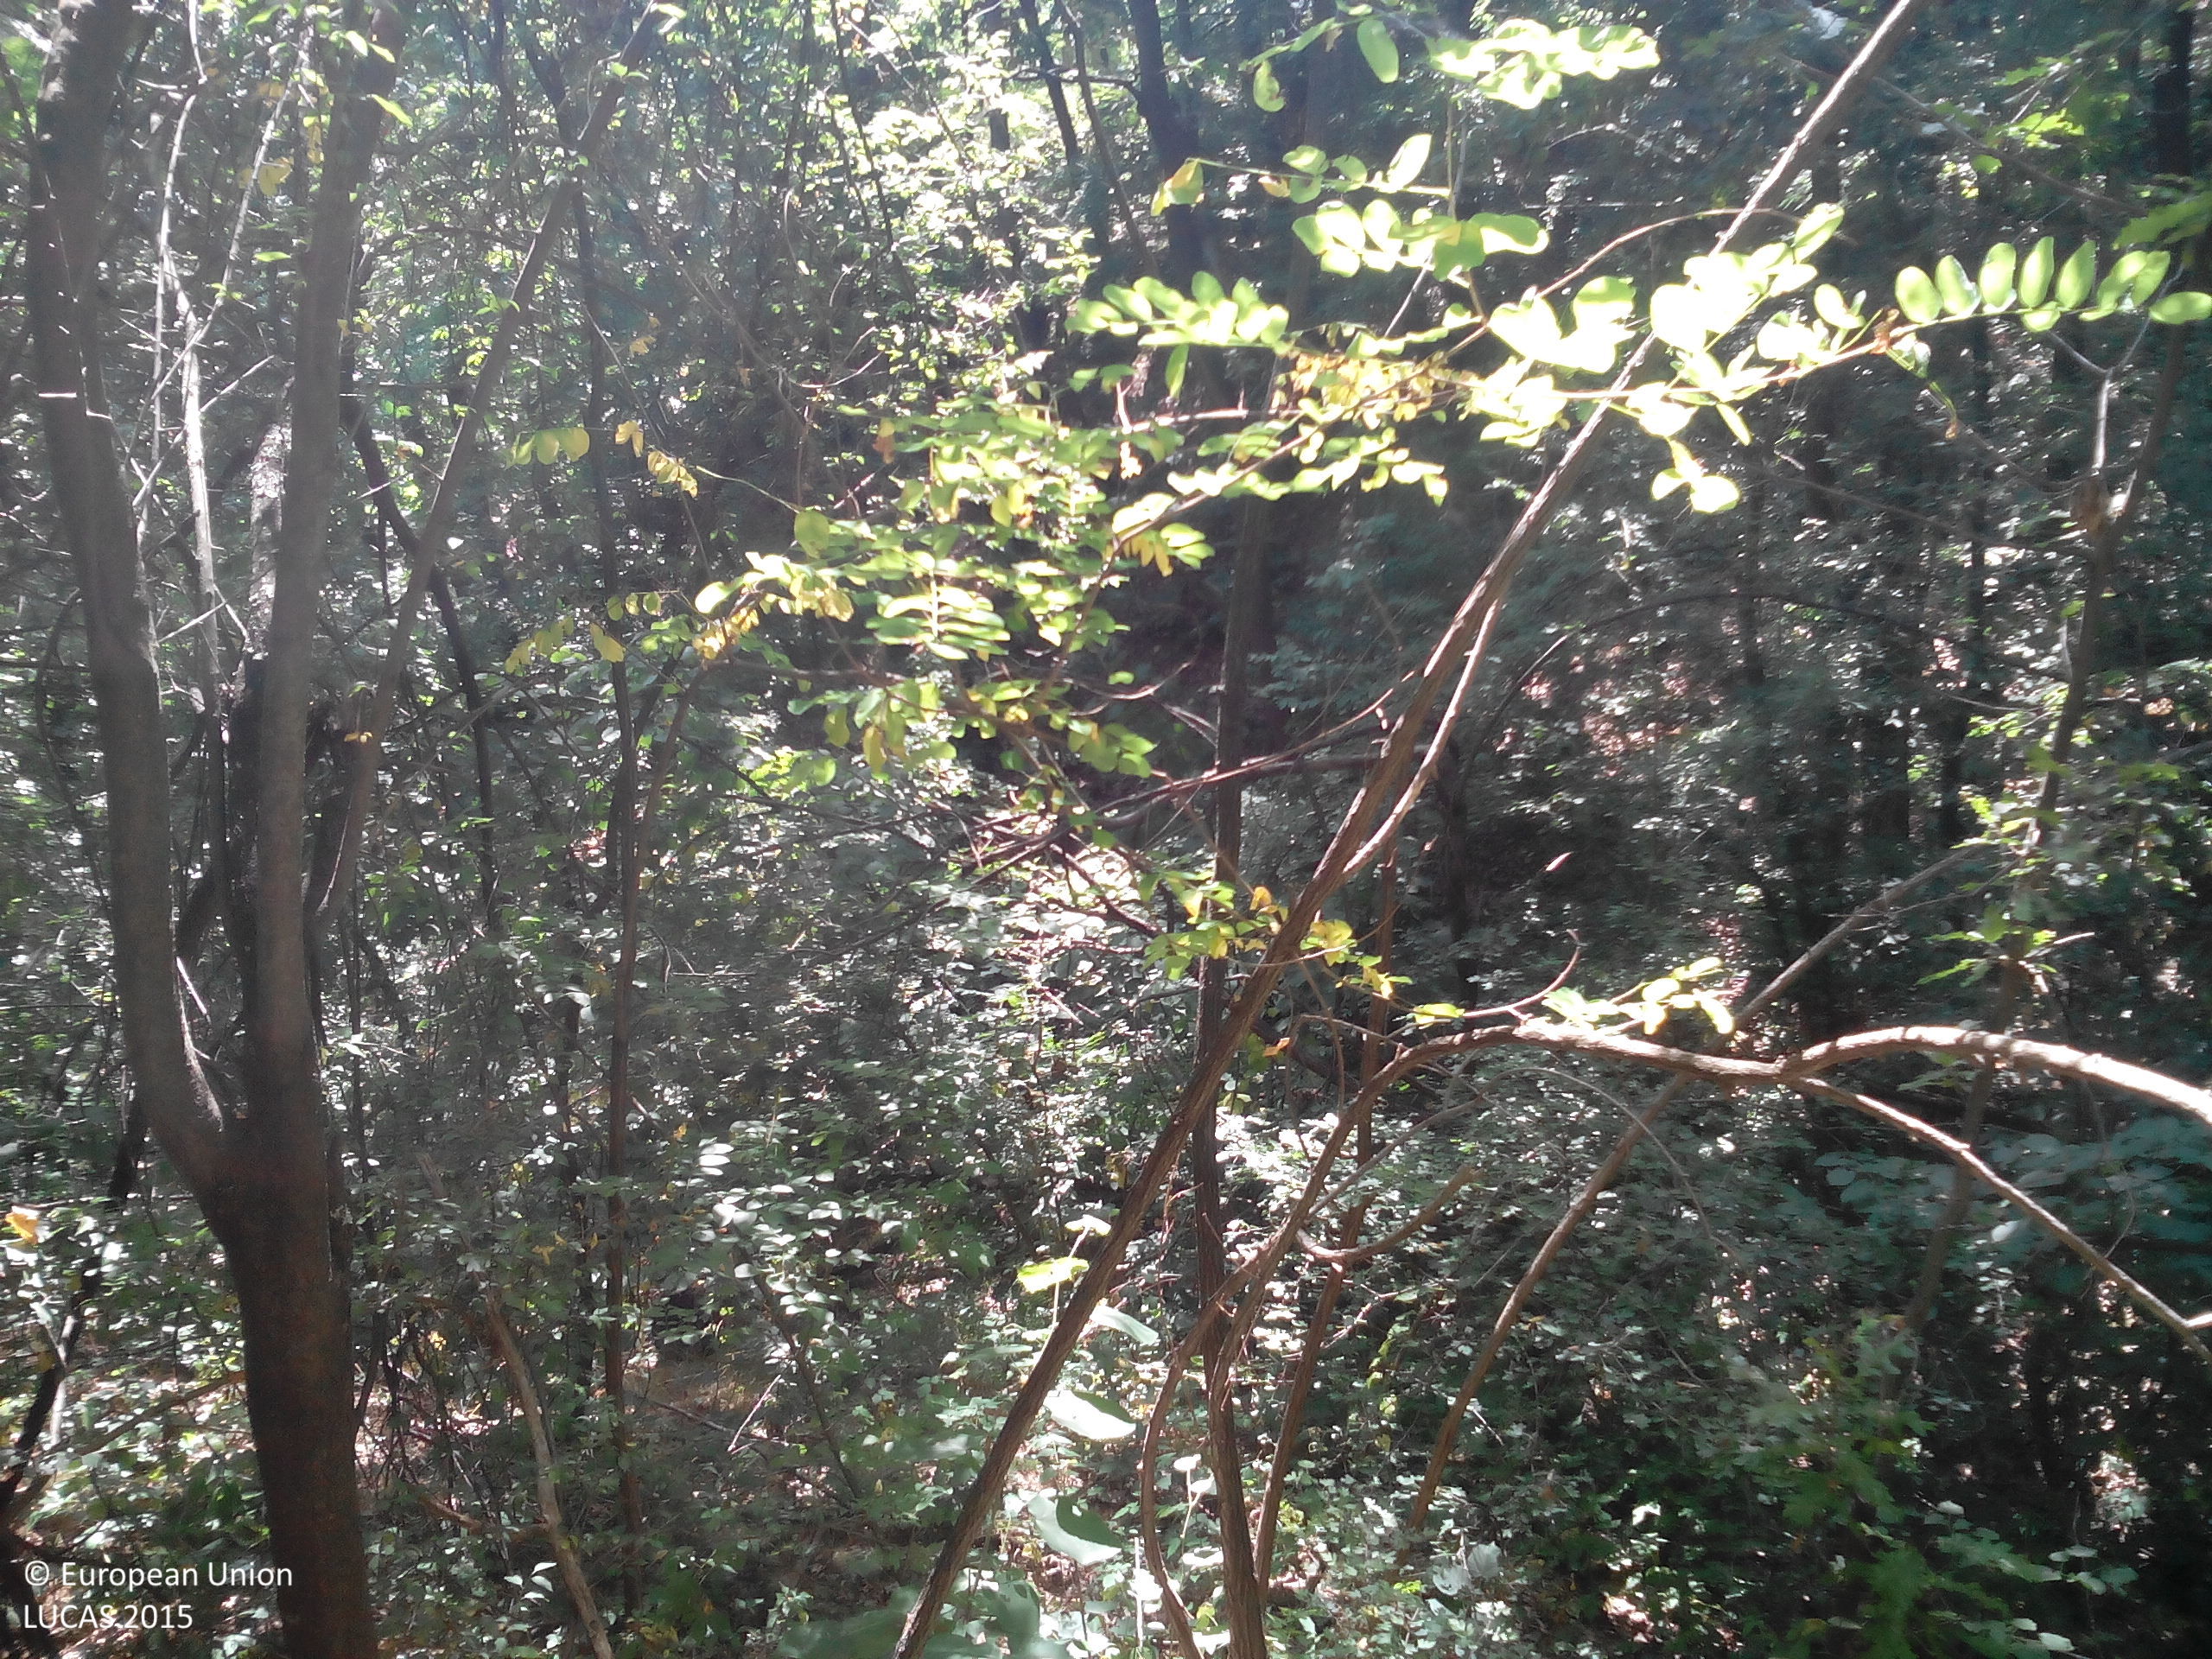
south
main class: Woodland
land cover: Broadleaved woodland
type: mesophytic deciduous forest
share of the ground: > 75 %
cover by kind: broadleaved forest trees 90 %, shrubs 5 %, herbaceous plants 5 %
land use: Forestry
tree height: > 5 m
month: August
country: BG
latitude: 43.1891
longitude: 23.6404
